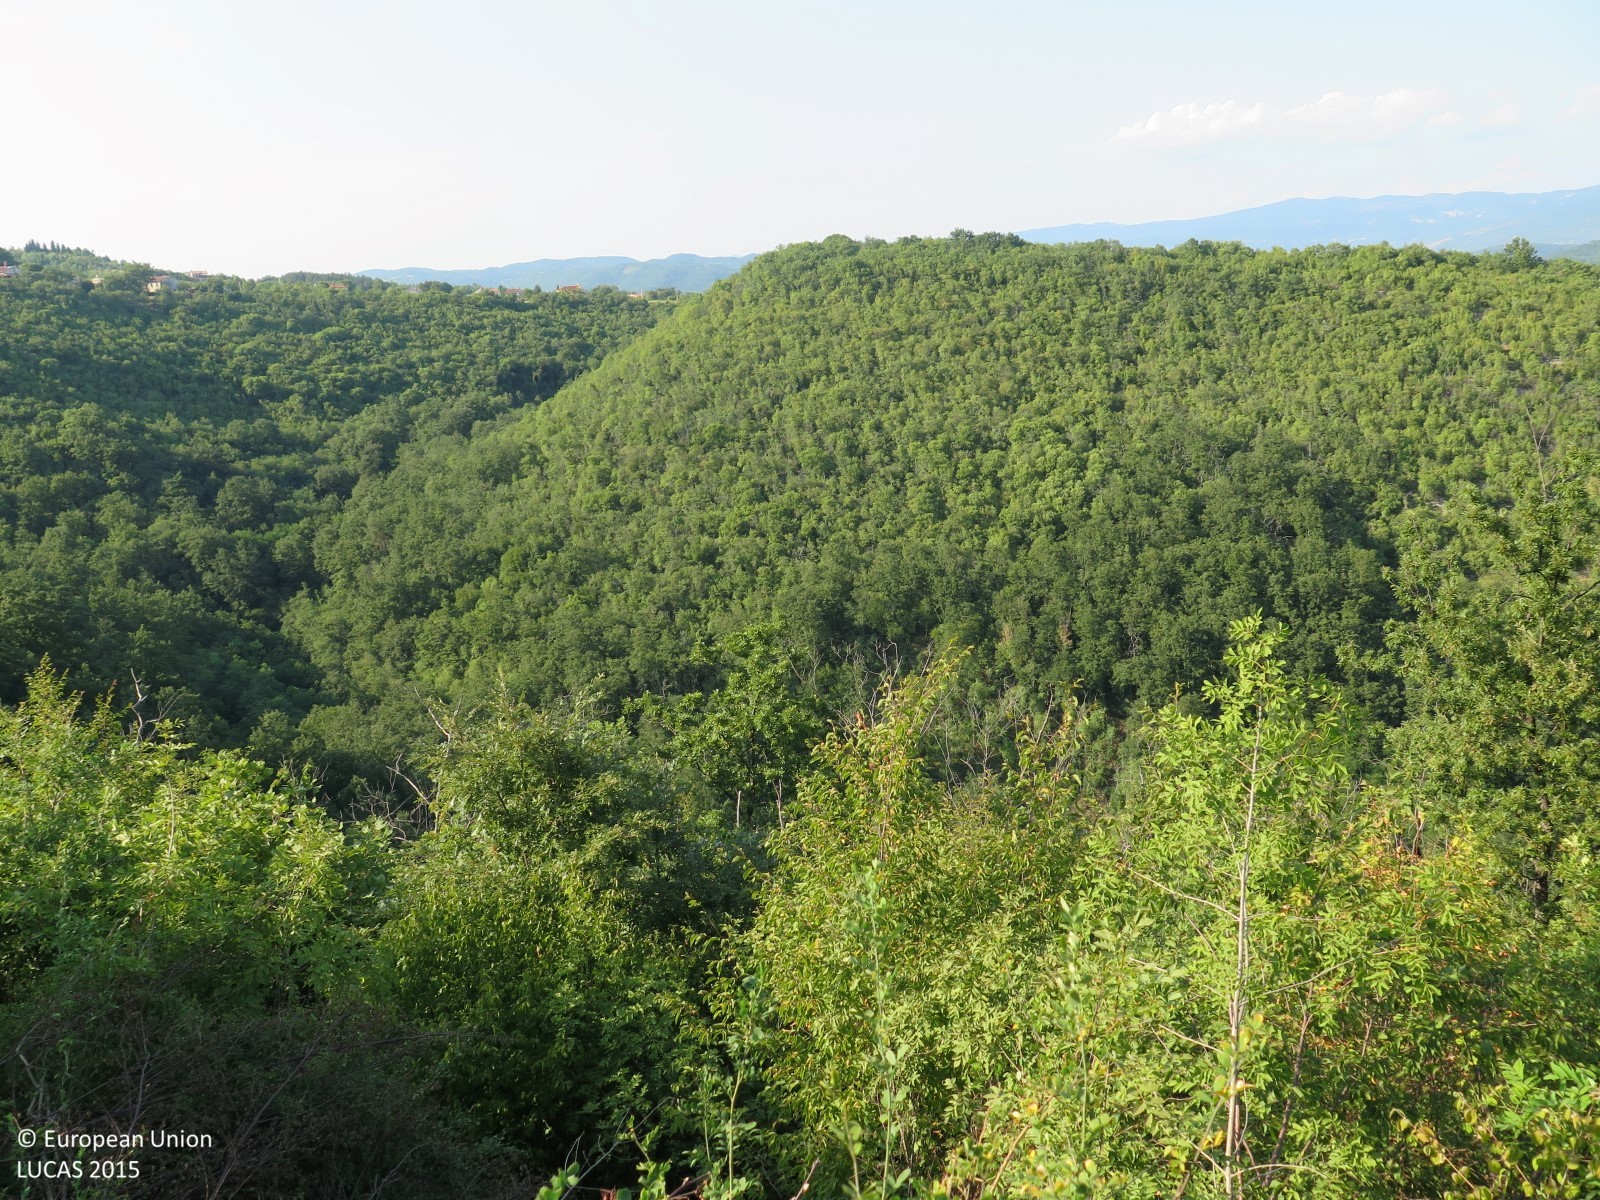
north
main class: Woodland
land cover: Broadleaved woodland
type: acidophilous oak and oak-birch forest
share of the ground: > 75 %
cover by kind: broadleaved forest trees 90 %, shrubs 5 %, herbaceous plants 5 %
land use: Semi-natural and natural areas not in use
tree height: > 5 m
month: July
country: HR
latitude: 45.1920
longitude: 14.0550
